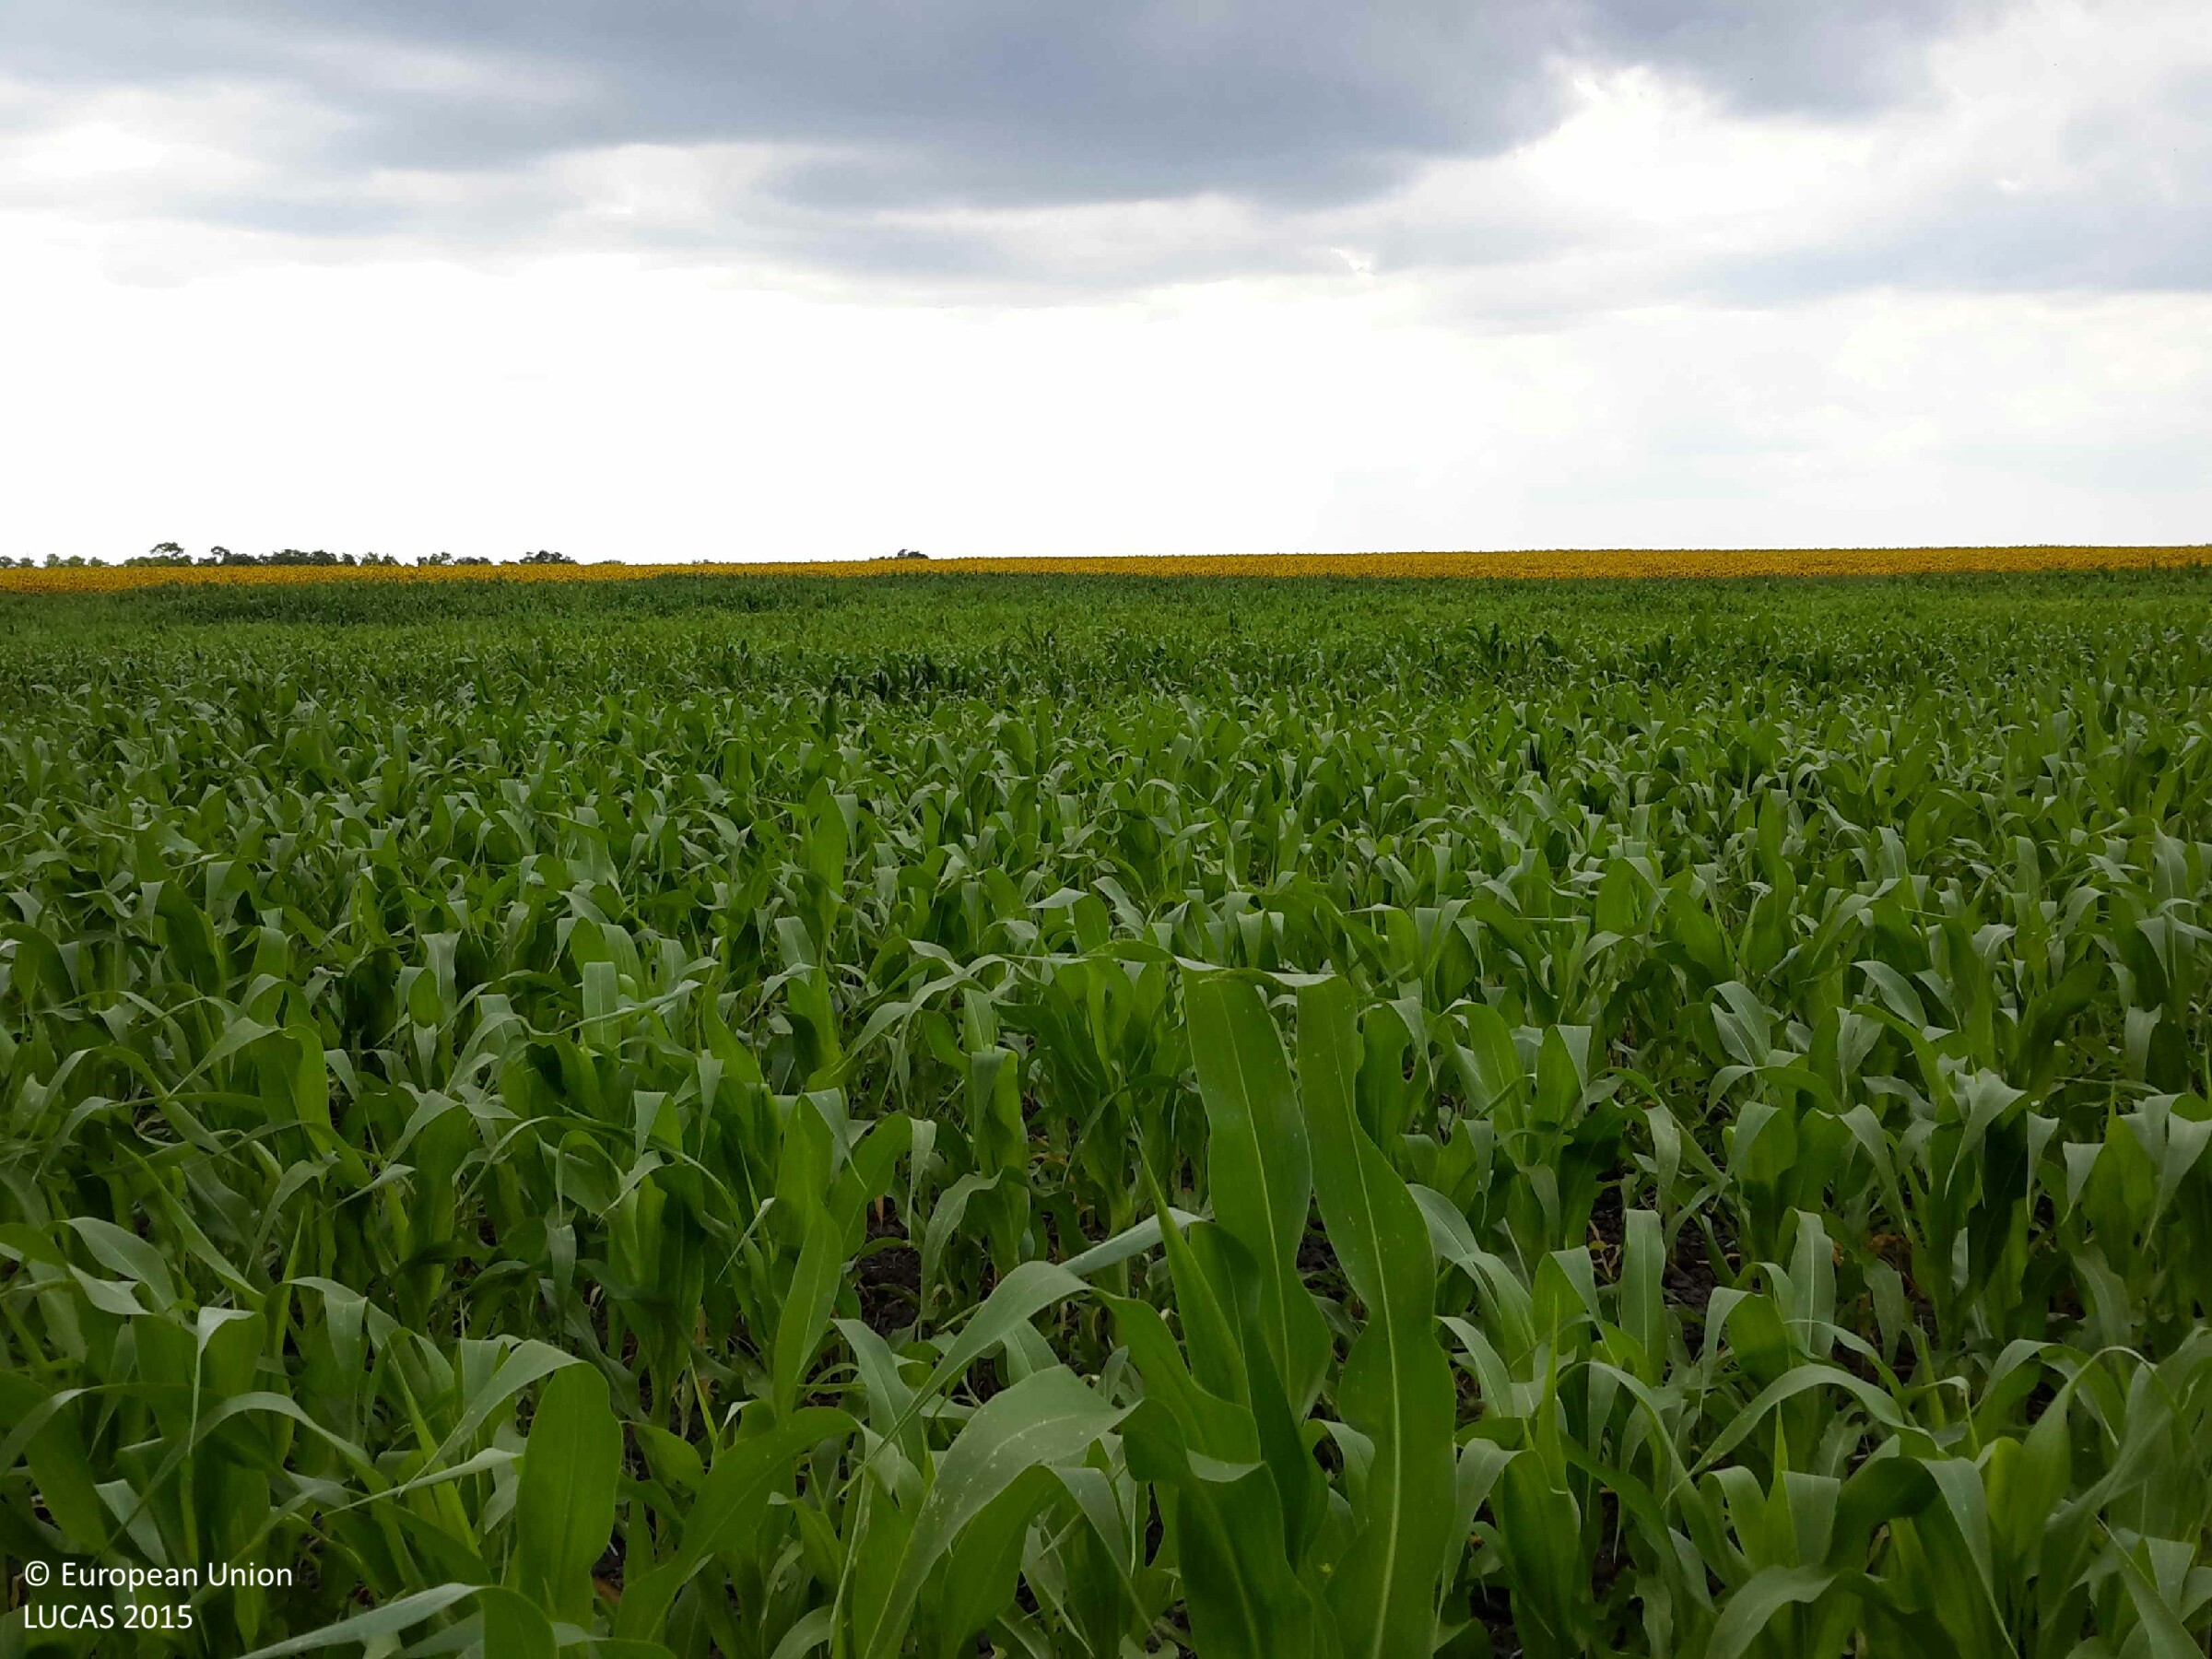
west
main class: Cropland
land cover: Maize
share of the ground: > 75 %
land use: Agriculture (excluding fallow land and kitchen gardens)
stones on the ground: < 10 %
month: July
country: HU
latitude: 47.6398
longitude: 17.7967
